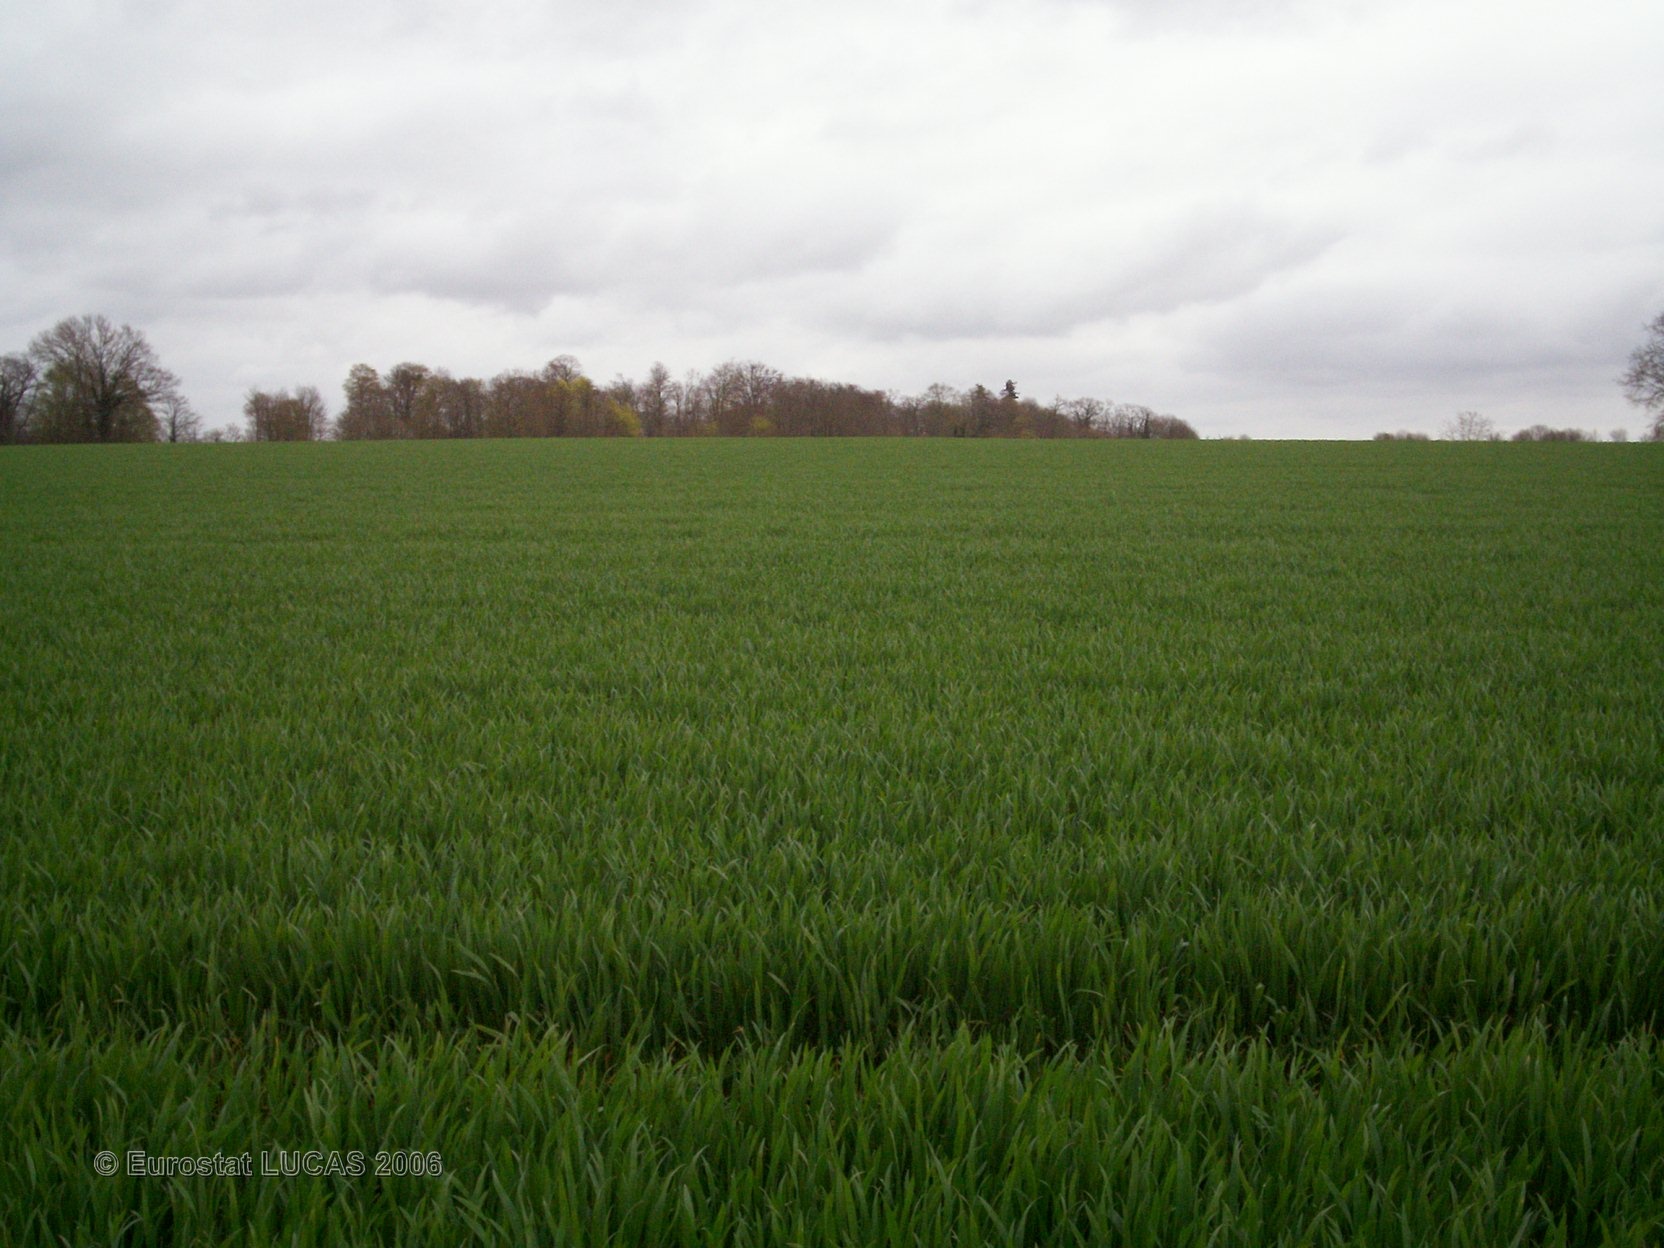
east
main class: Cropland
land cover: Common wheat
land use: Agriculture (excluding fallow land and kitchen gardens)
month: April
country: FR
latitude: 46.2788
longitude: -0.2102
